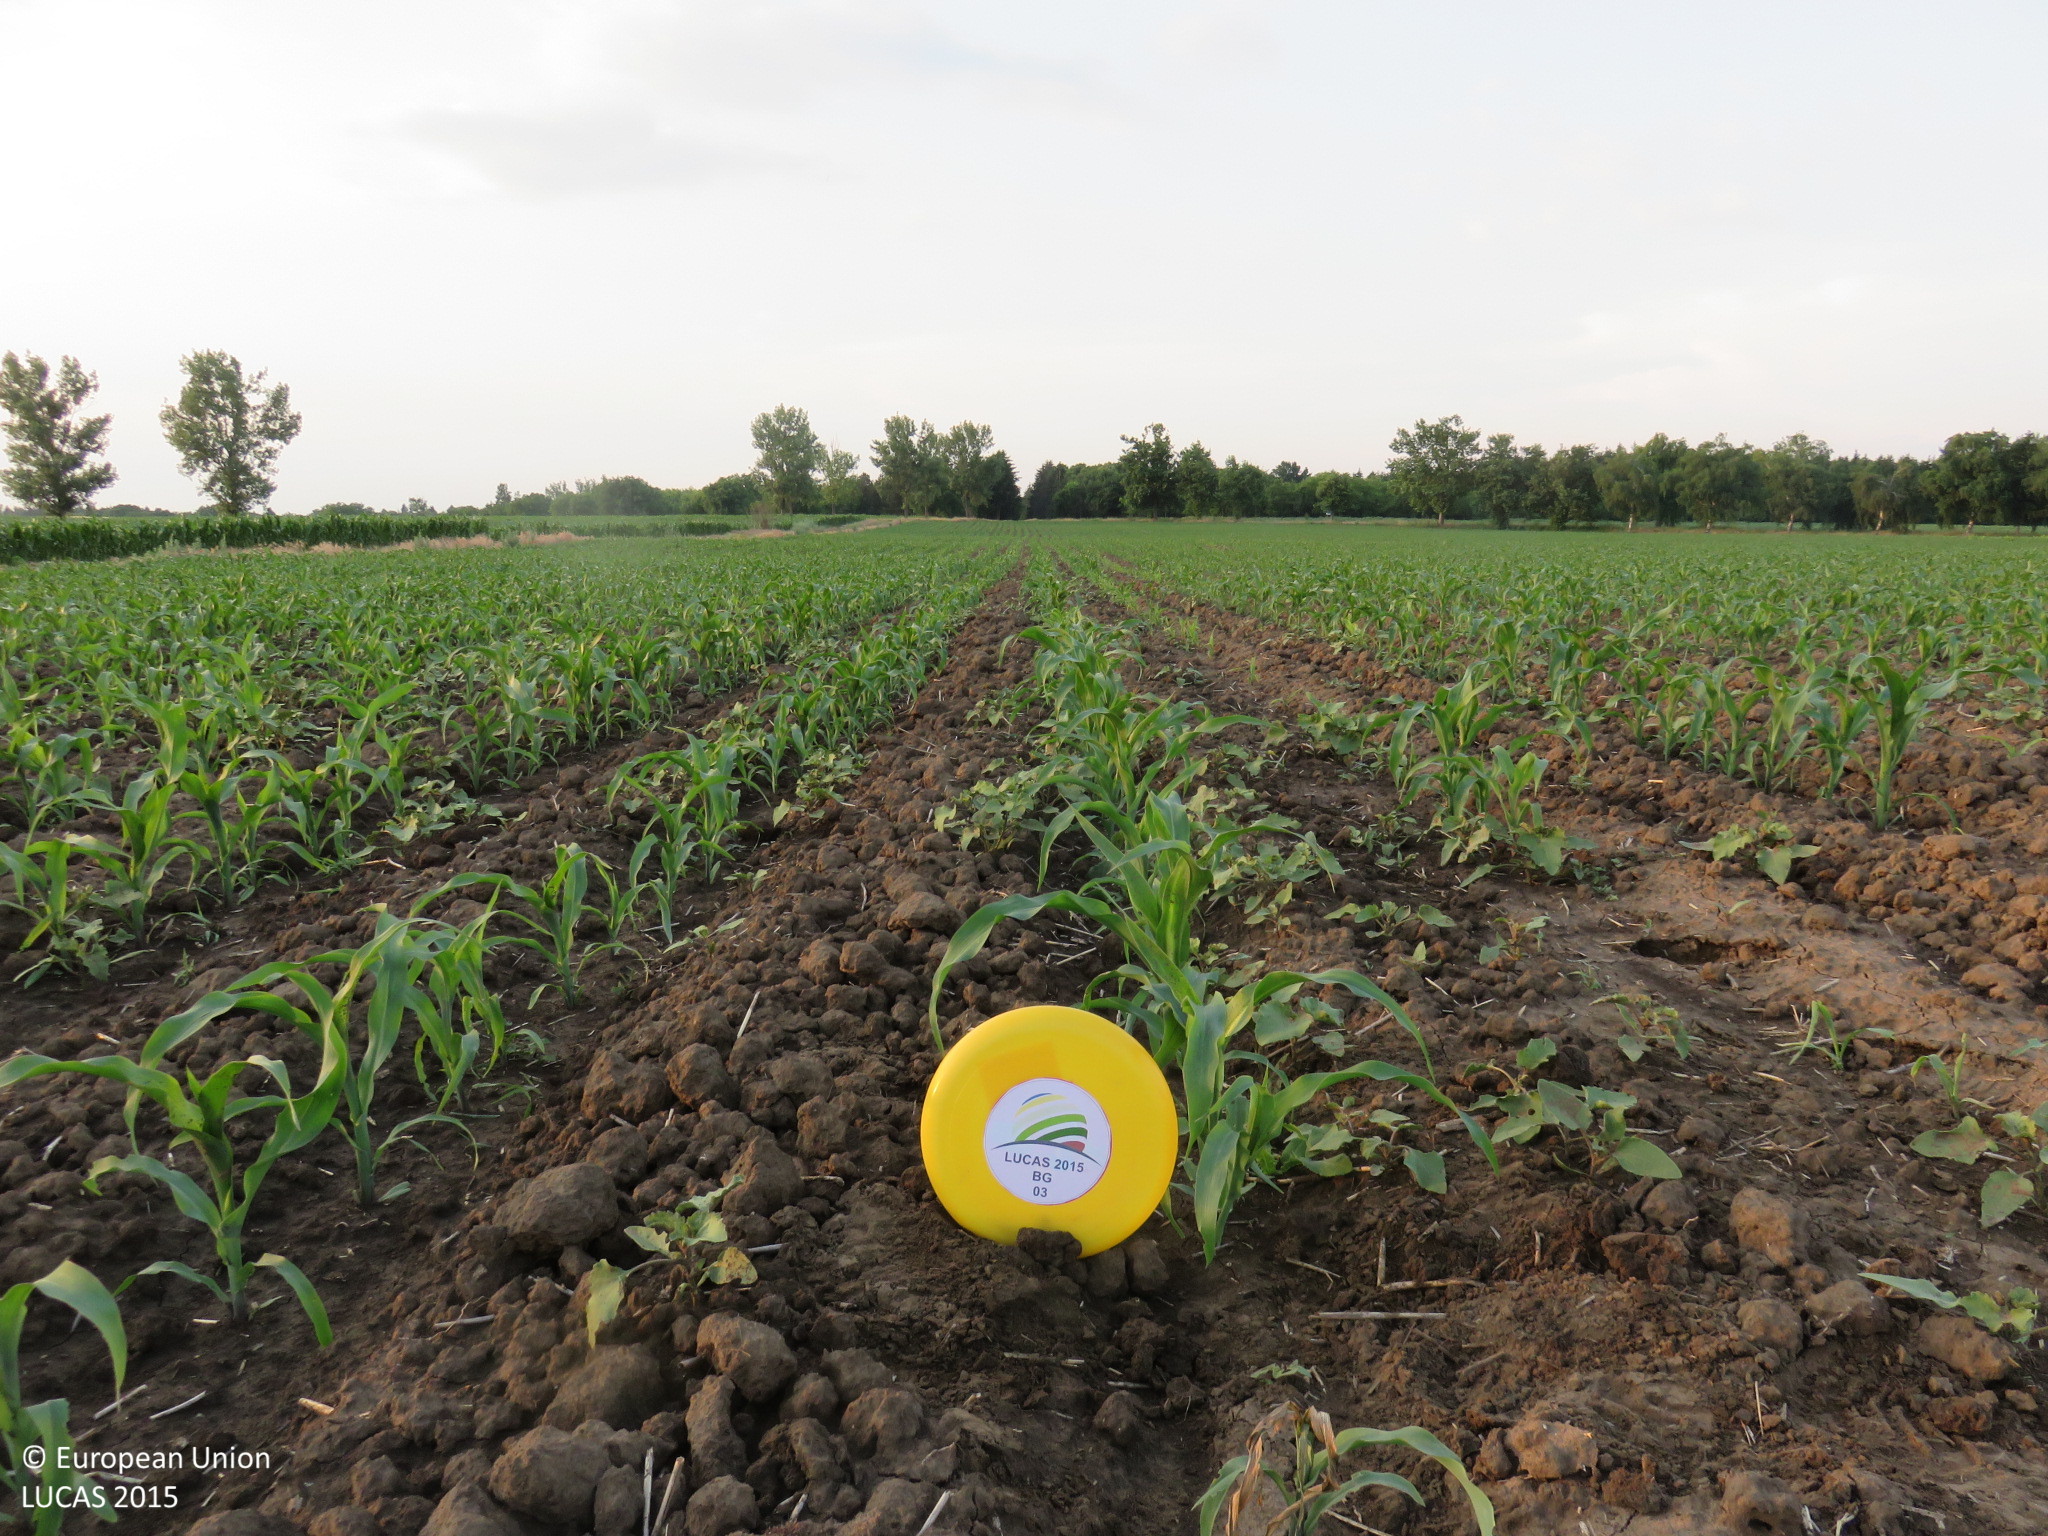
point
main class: Cropland
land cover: Maize
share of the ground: 25 - 50 %
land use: Agriculture (excluding fallow land and kitchen gardens)
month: June
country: BG
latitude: 43.6080
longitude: 24.4460
